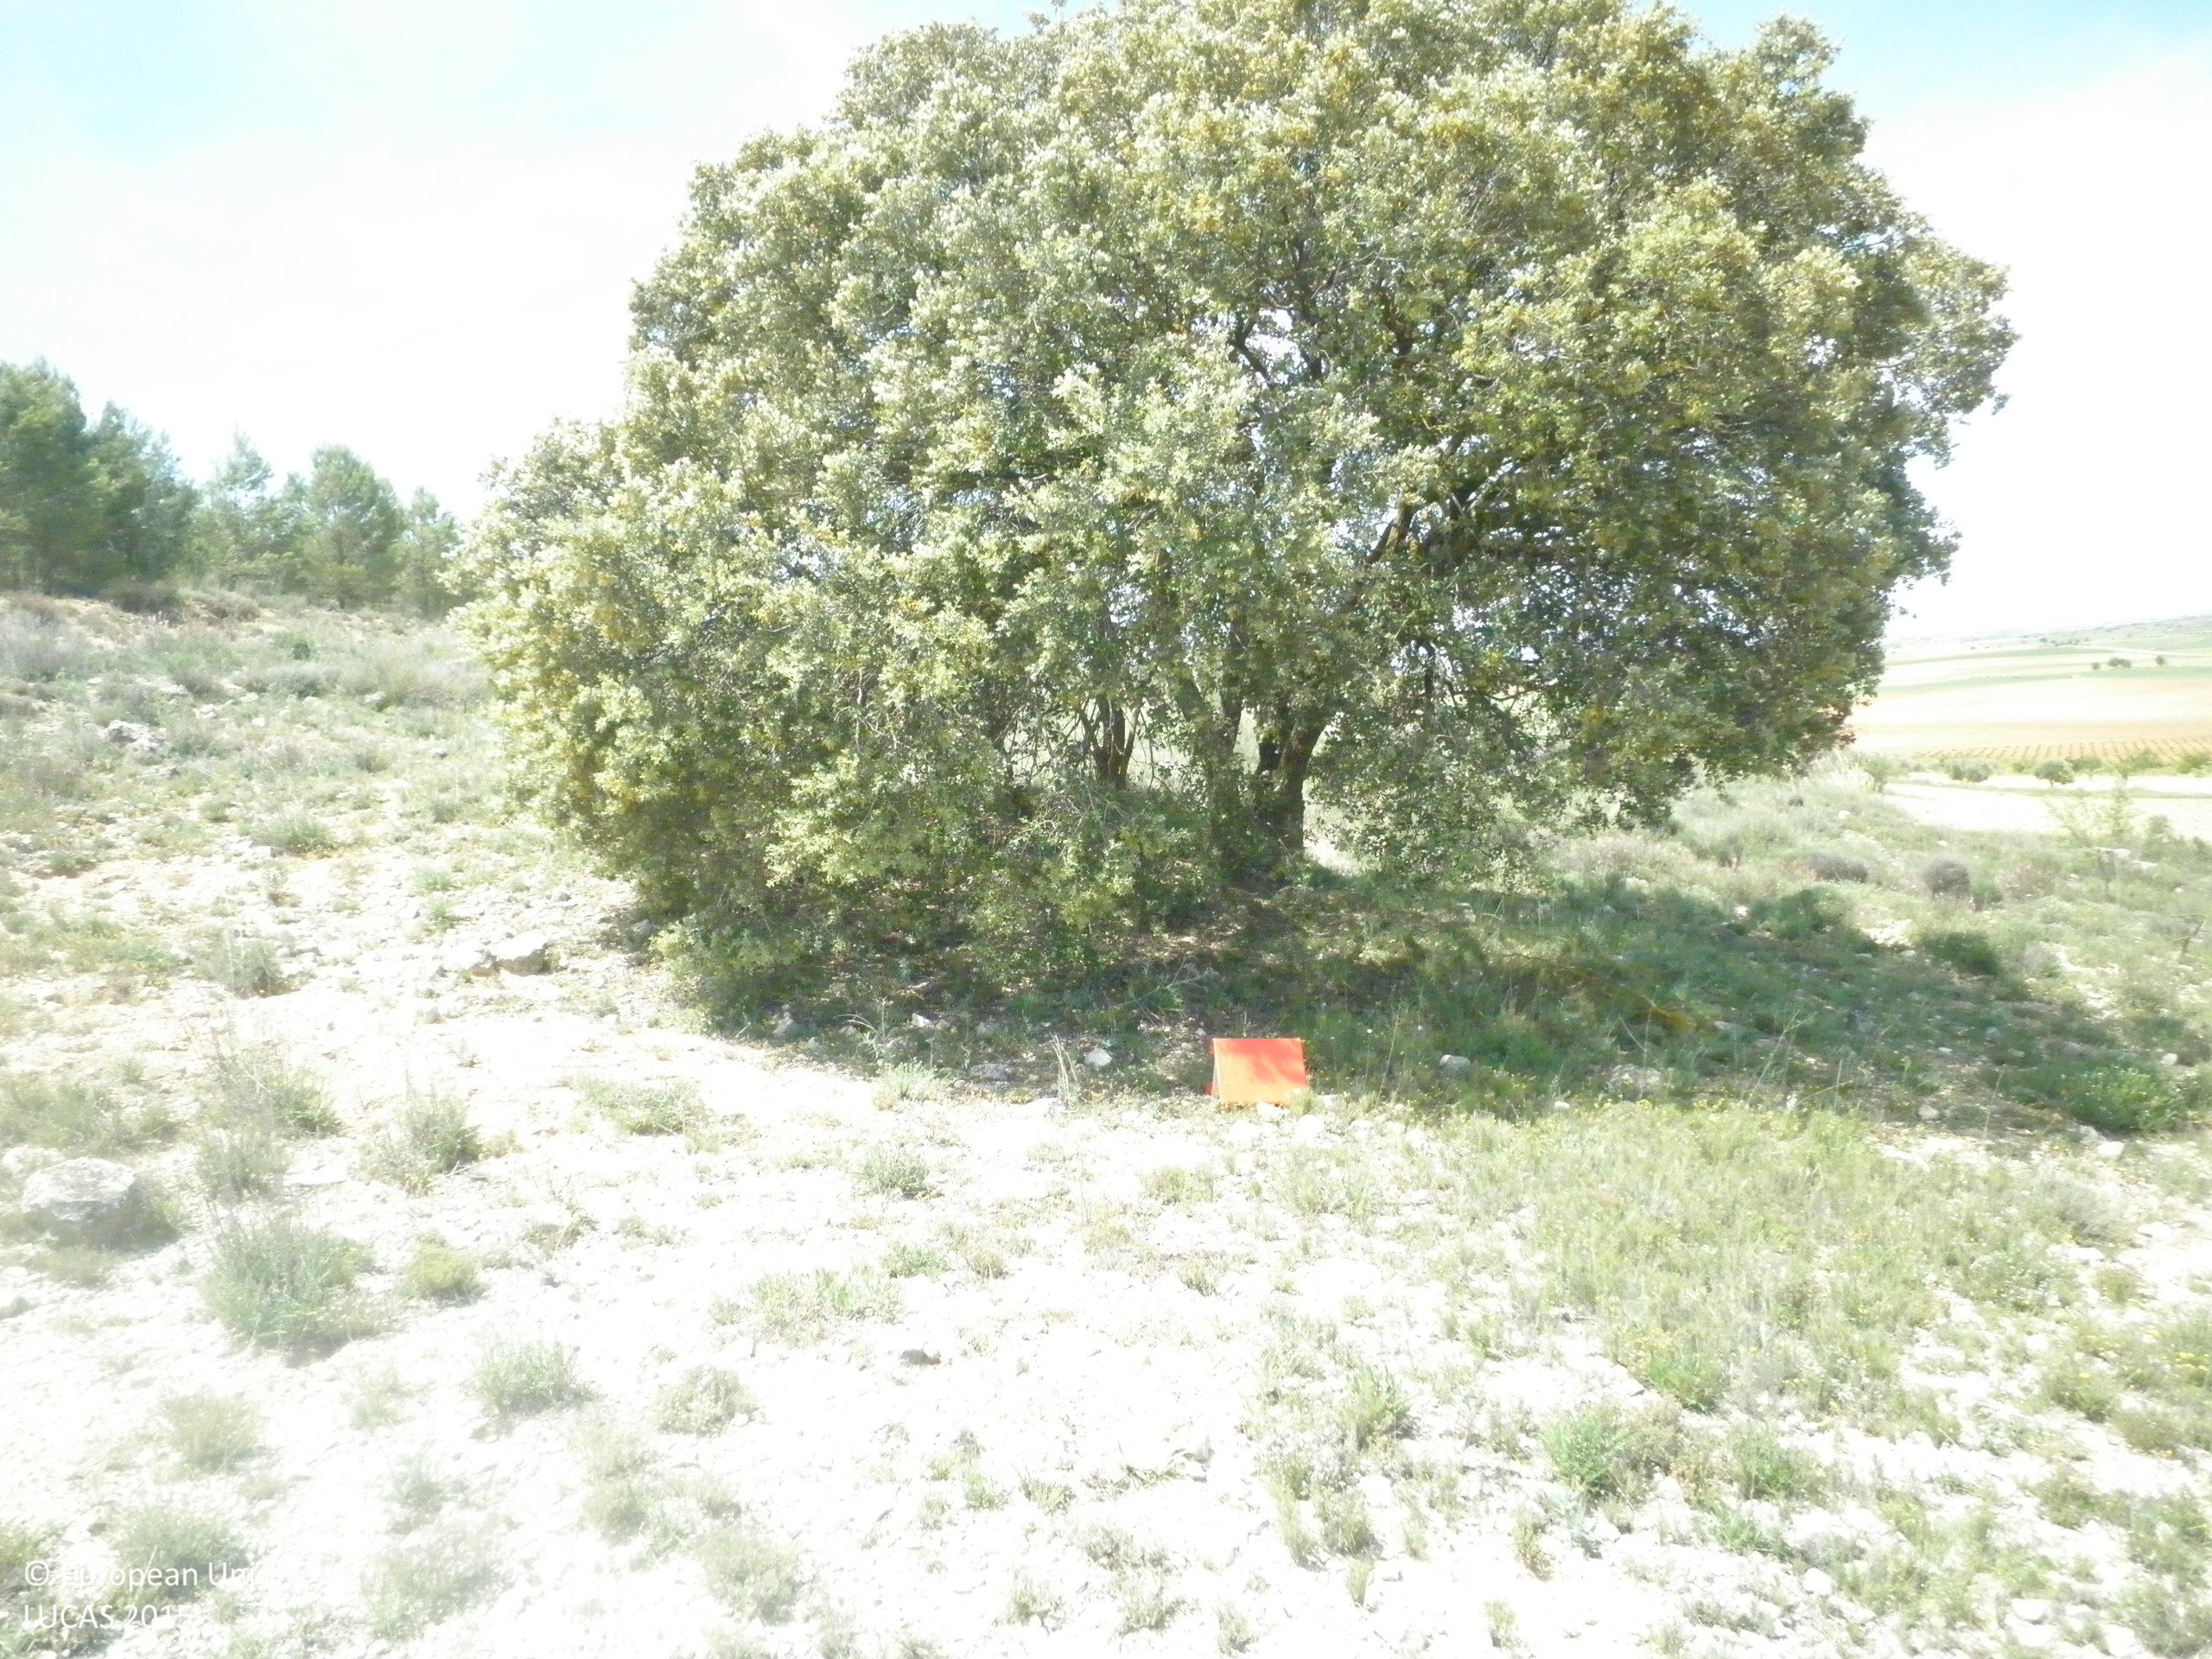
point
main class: Shrubland
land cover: Shrubland with sparse tree cover
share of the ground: 50 - 75 %
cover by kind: unconsolidated bare surface 45 %, shrubs 30 %, herbaceous plants 20 %, broadleaved forest trees 5 %
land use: Semi-natural and natural areas not in use
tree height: < 5 m
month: May
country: ES
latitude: 39.5824
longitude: -2.7174
